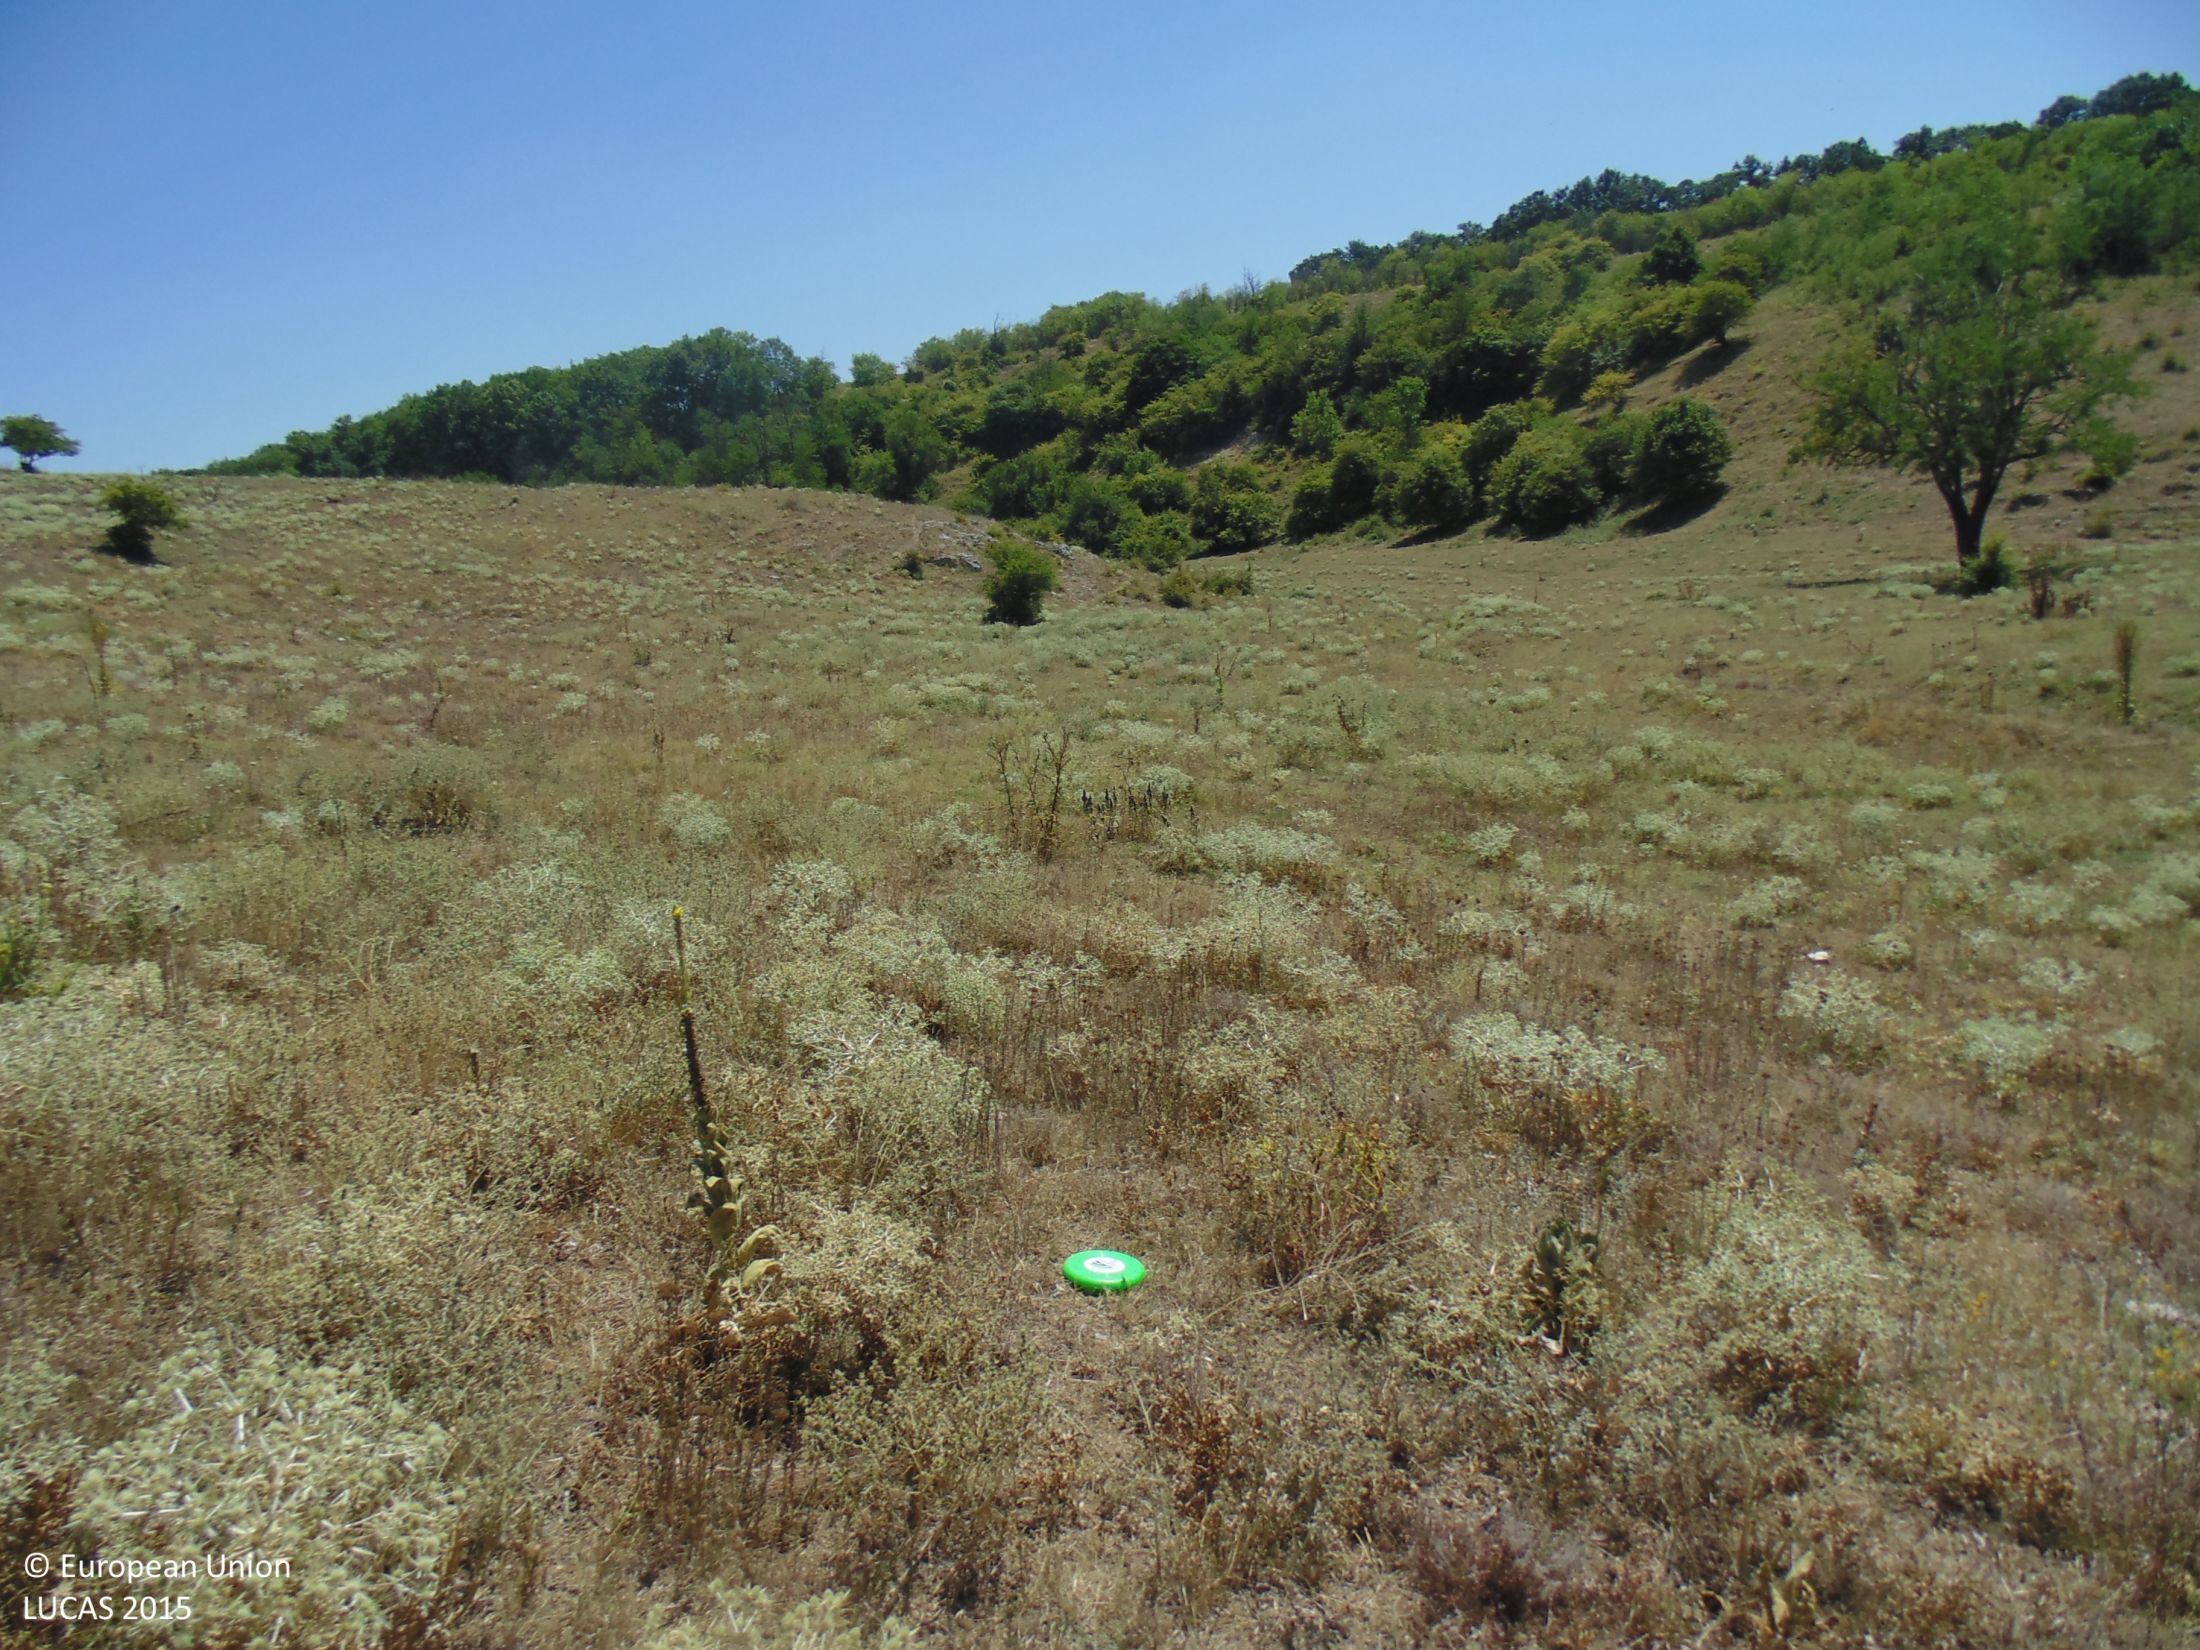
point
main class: Grassland
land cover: Grassland with sparse tree/shrub cover
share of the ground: > 75 %
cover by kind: herbaceous plants 90 %, broadleaved forest trees 5 %, shrubs 5 %
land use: Agriculture (excluding fallow land and kitchen gardens)
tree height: < 5 m
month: July
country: BG
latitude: 43.6908
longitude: 27.7455
